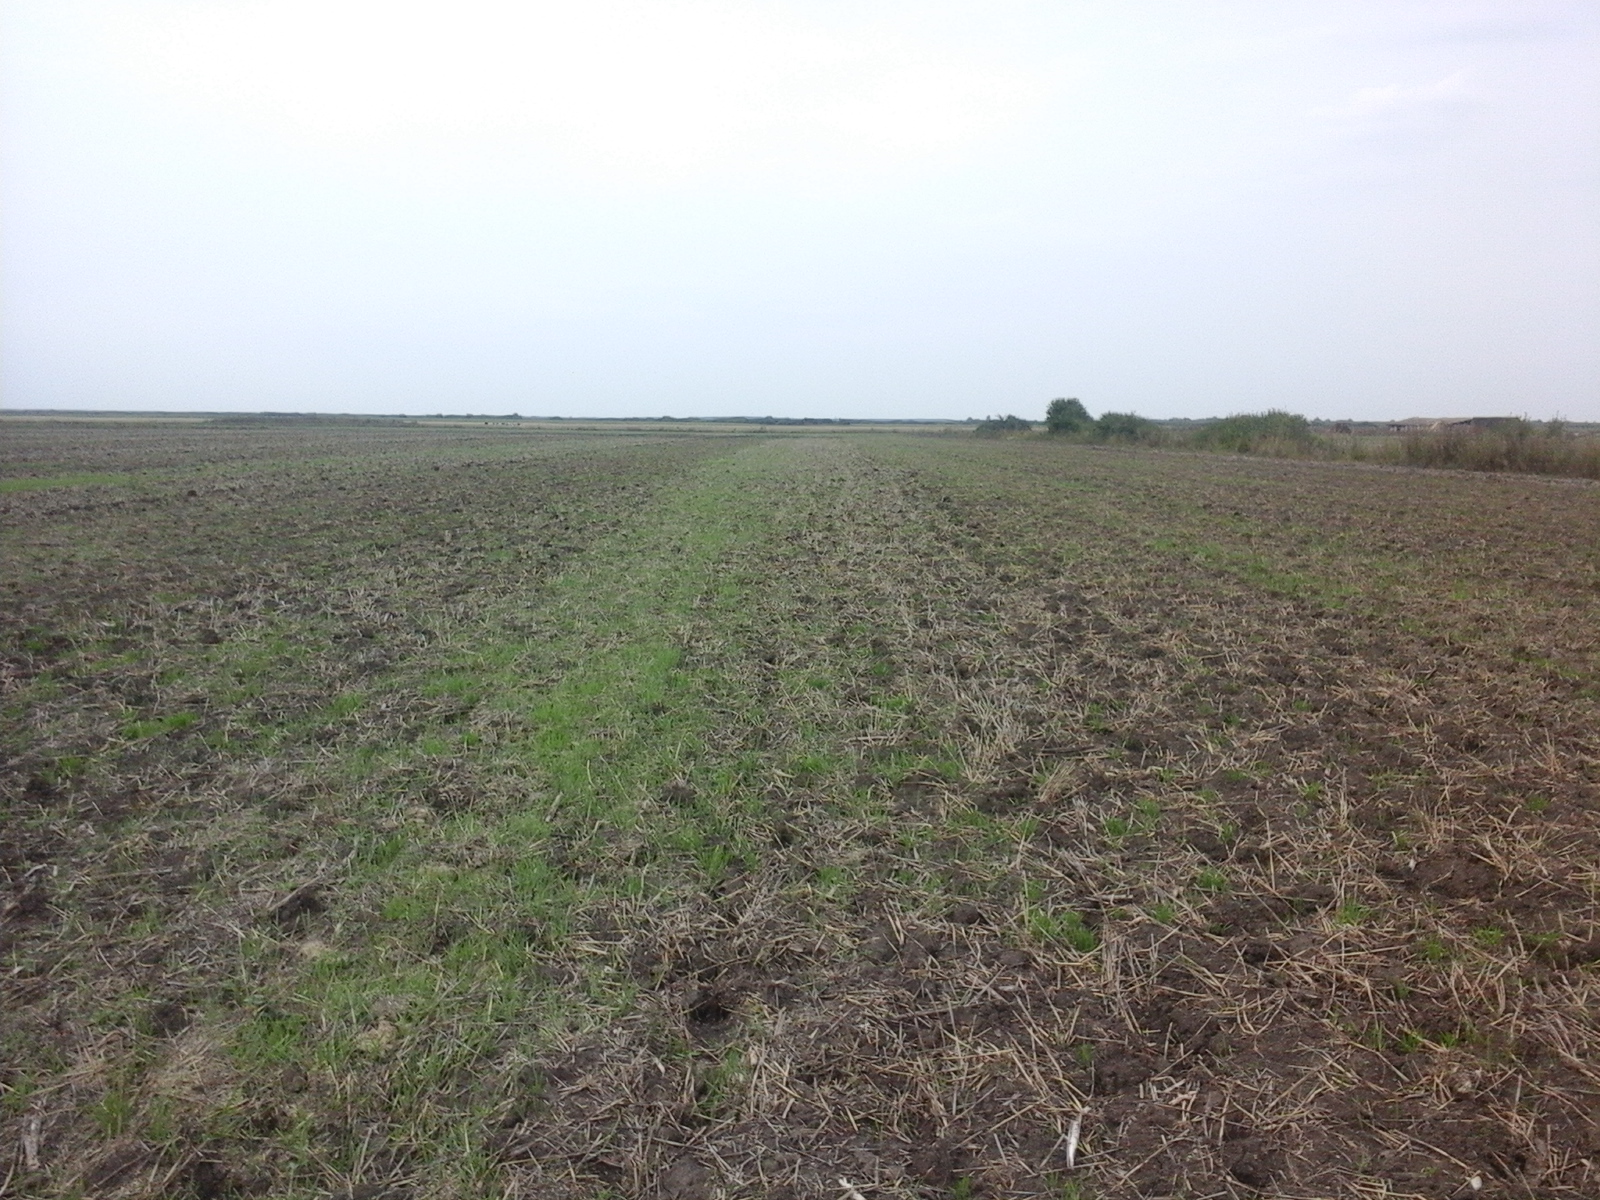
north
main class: Cropland
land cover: Common wheat
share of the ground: < 10 %
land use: Agriculture (excluding fallow land and kitchen gardens)
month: August
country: RO
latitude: 46.5757
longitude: 21.4021
